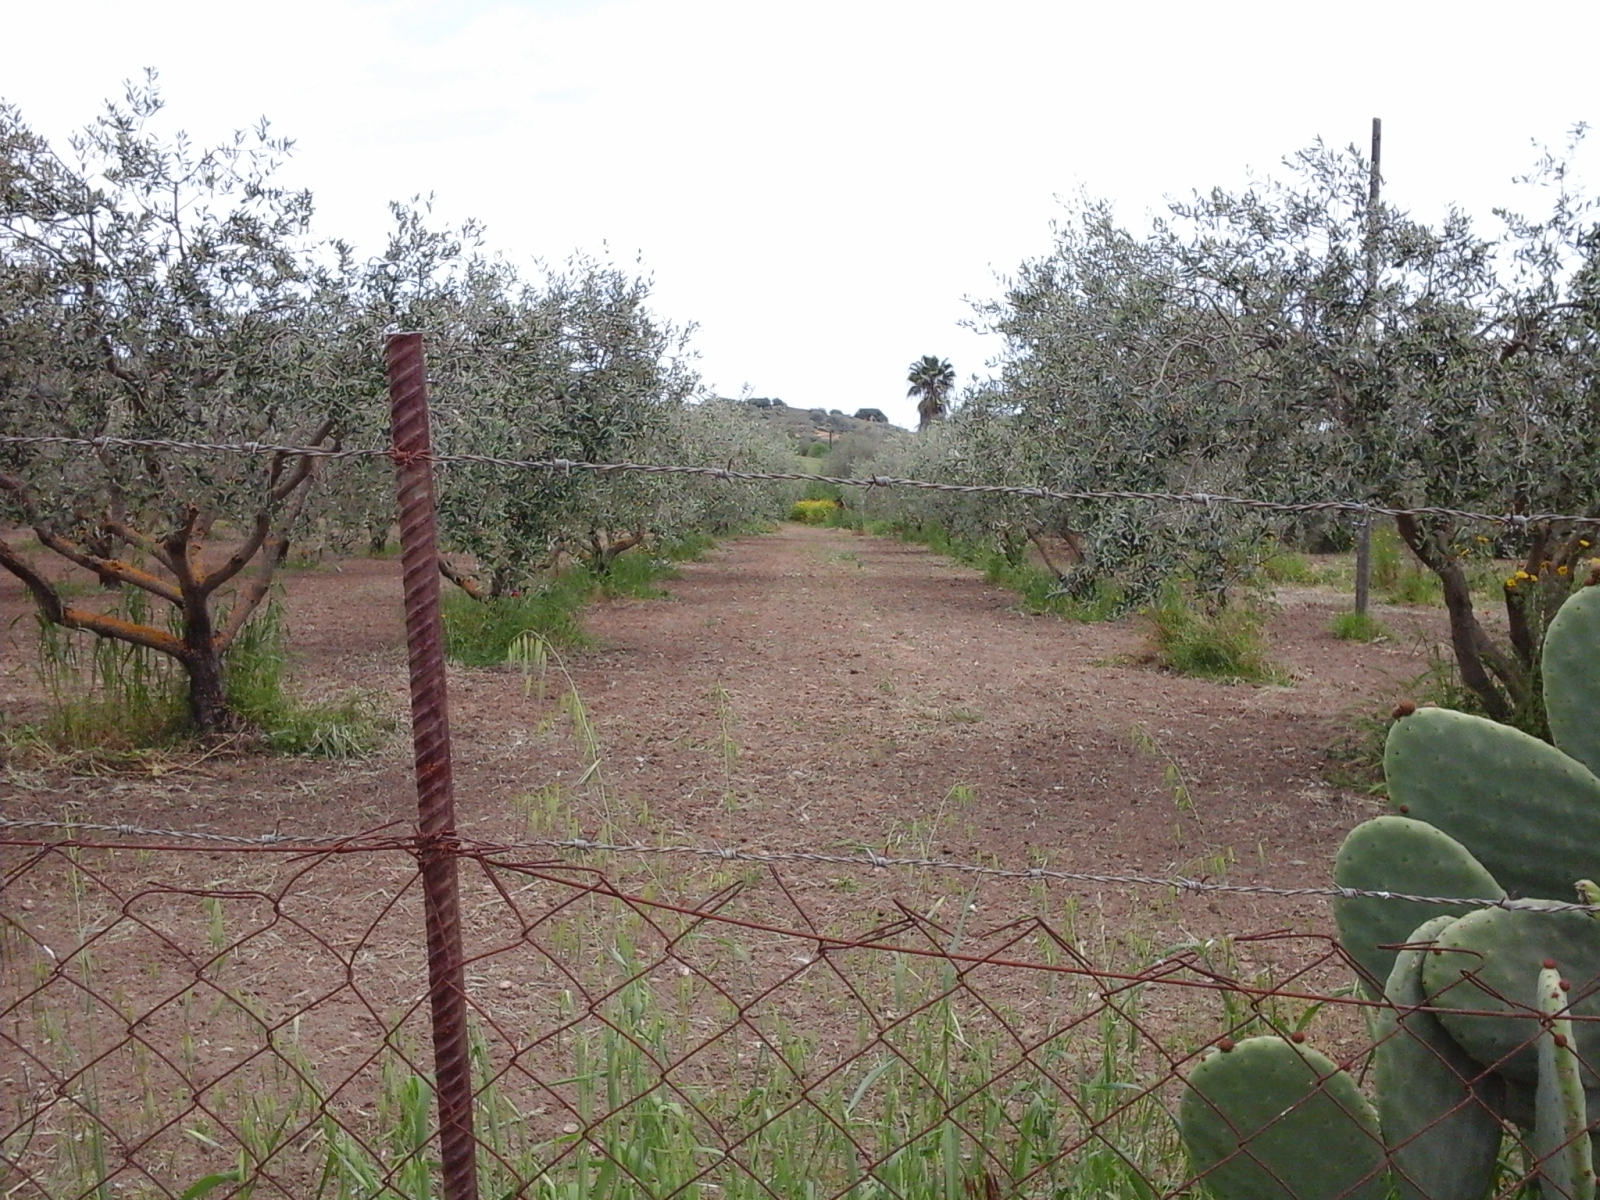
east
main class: Cropland
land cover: Olive groves
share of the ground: 50 - 75 %
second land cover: Other bare soil
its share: > 75 %
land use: Agriculture (excluding fallow land and kitchen gardens)
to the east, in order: Olive groves; Other bare soil; Fences; Other bare soil; Fences; Paved roads, cycling and walking lanes; Fences; Olive groves; Fences; Other fruit trees and berries; Fences; Other fruit trees and berries; Spontaneously vegetated surfaces; Electric lines; Spontaneously vegetated surfaces; Other fruit trees and berries; Artificial constructions in urban areas
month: May
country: IT
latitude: 37.4192
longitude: 14.1831
